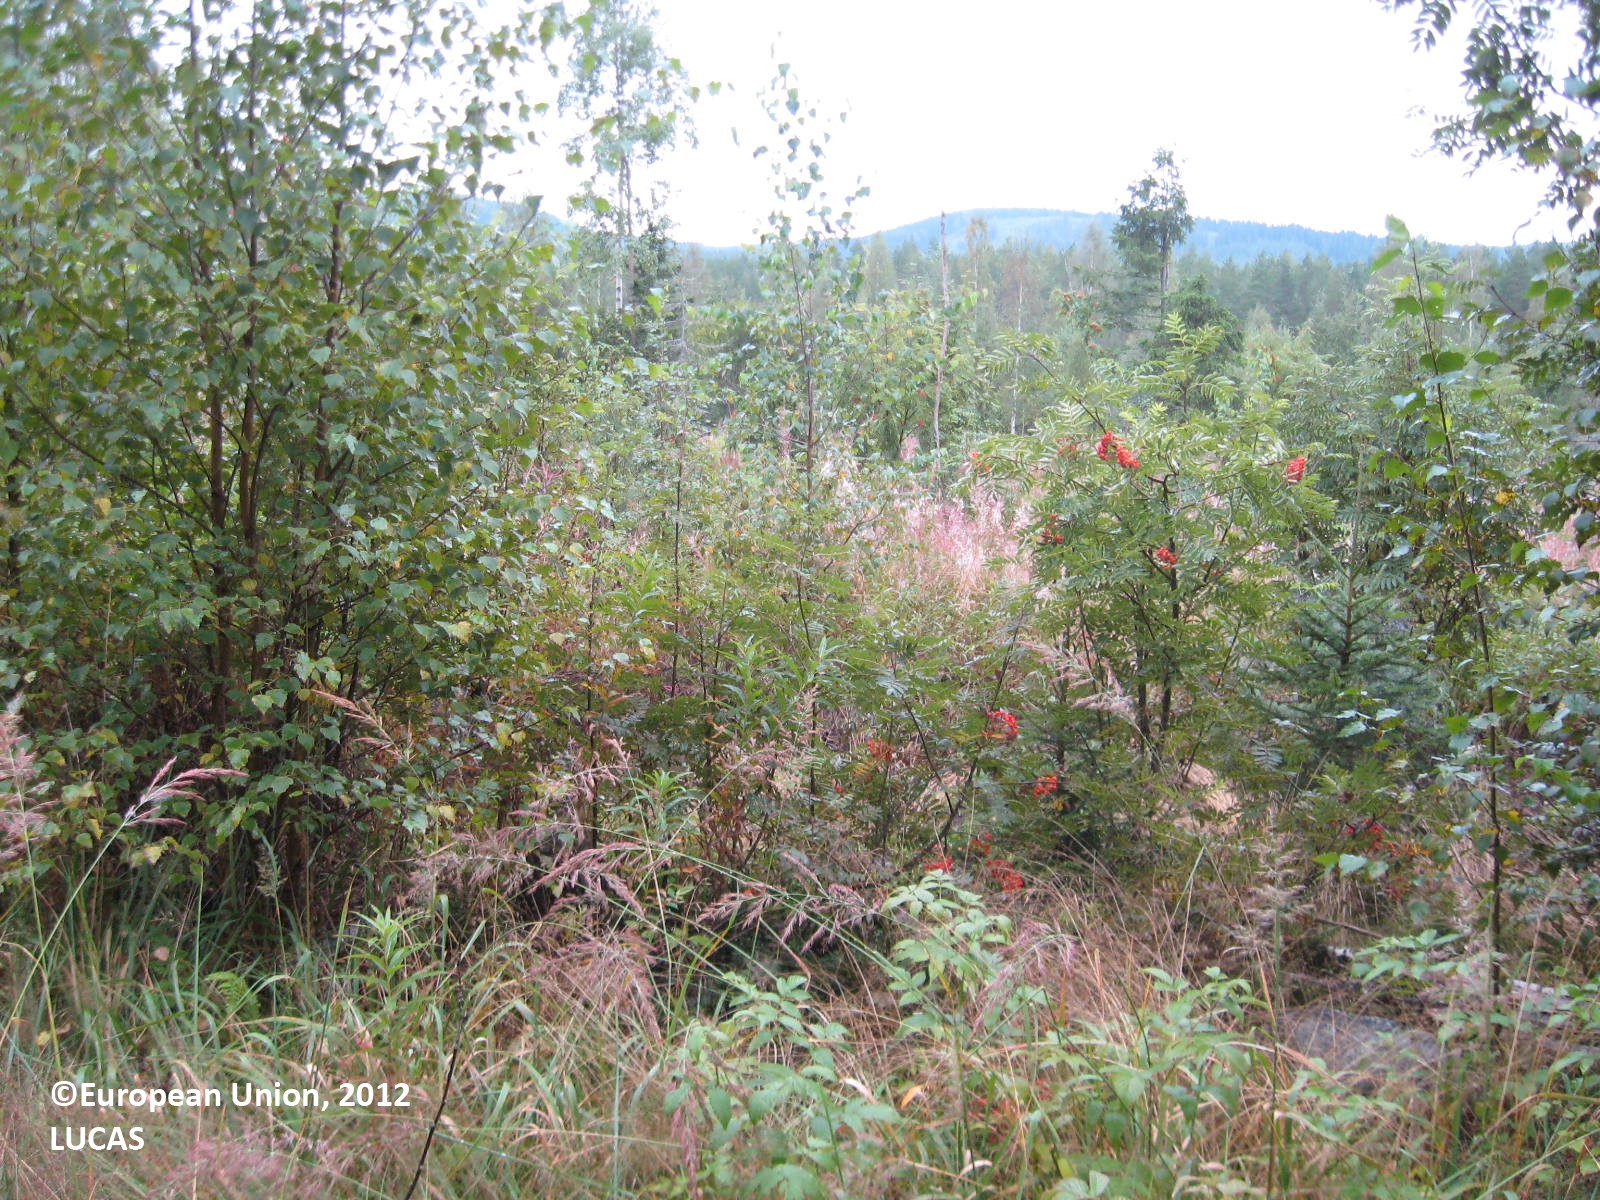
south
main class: Woodland
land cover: Broadleaved woodland
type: boreal forest
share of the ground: 50 - 75 %
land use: Forestry
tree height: > 5 m
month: August
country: FI
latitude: 63.4928
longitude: 29.7373
